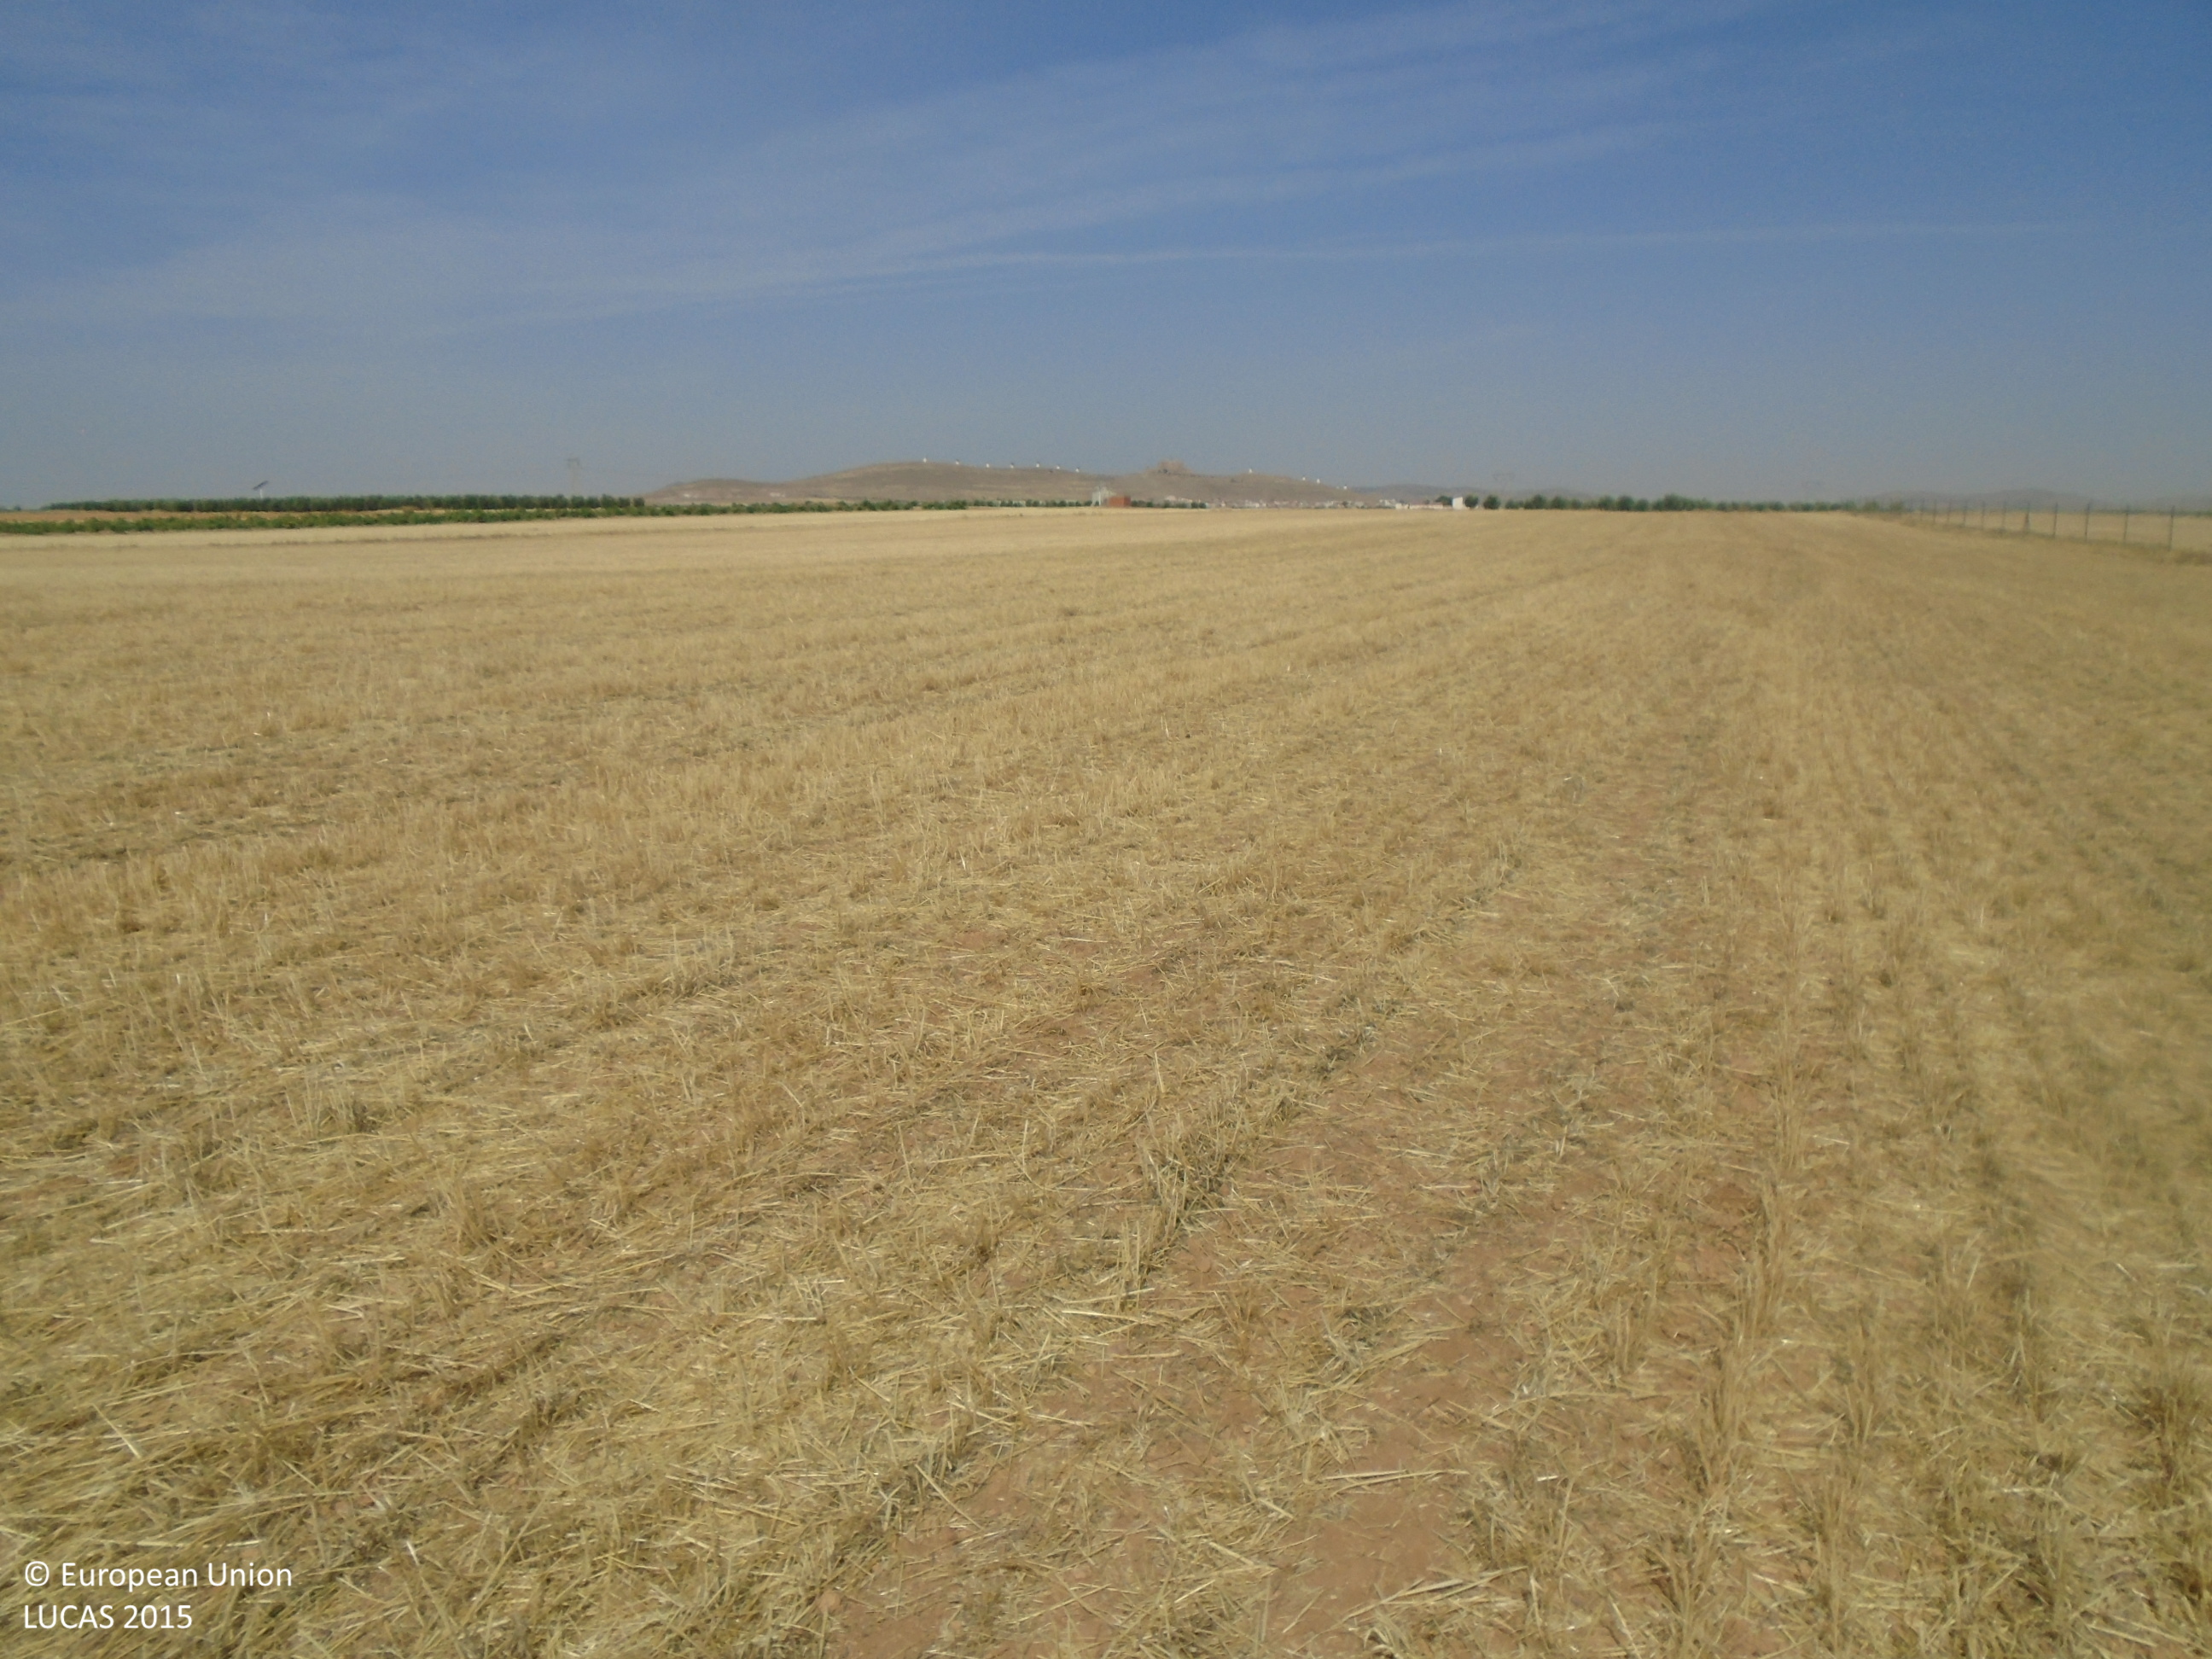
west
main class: Cropland
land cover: Oats
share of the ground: > 75 %
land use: Agriculture (excluding fallow land and kitchen gardens)
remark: Harvested field
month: July
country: ES
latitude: 39.4493
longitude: -3.5606
